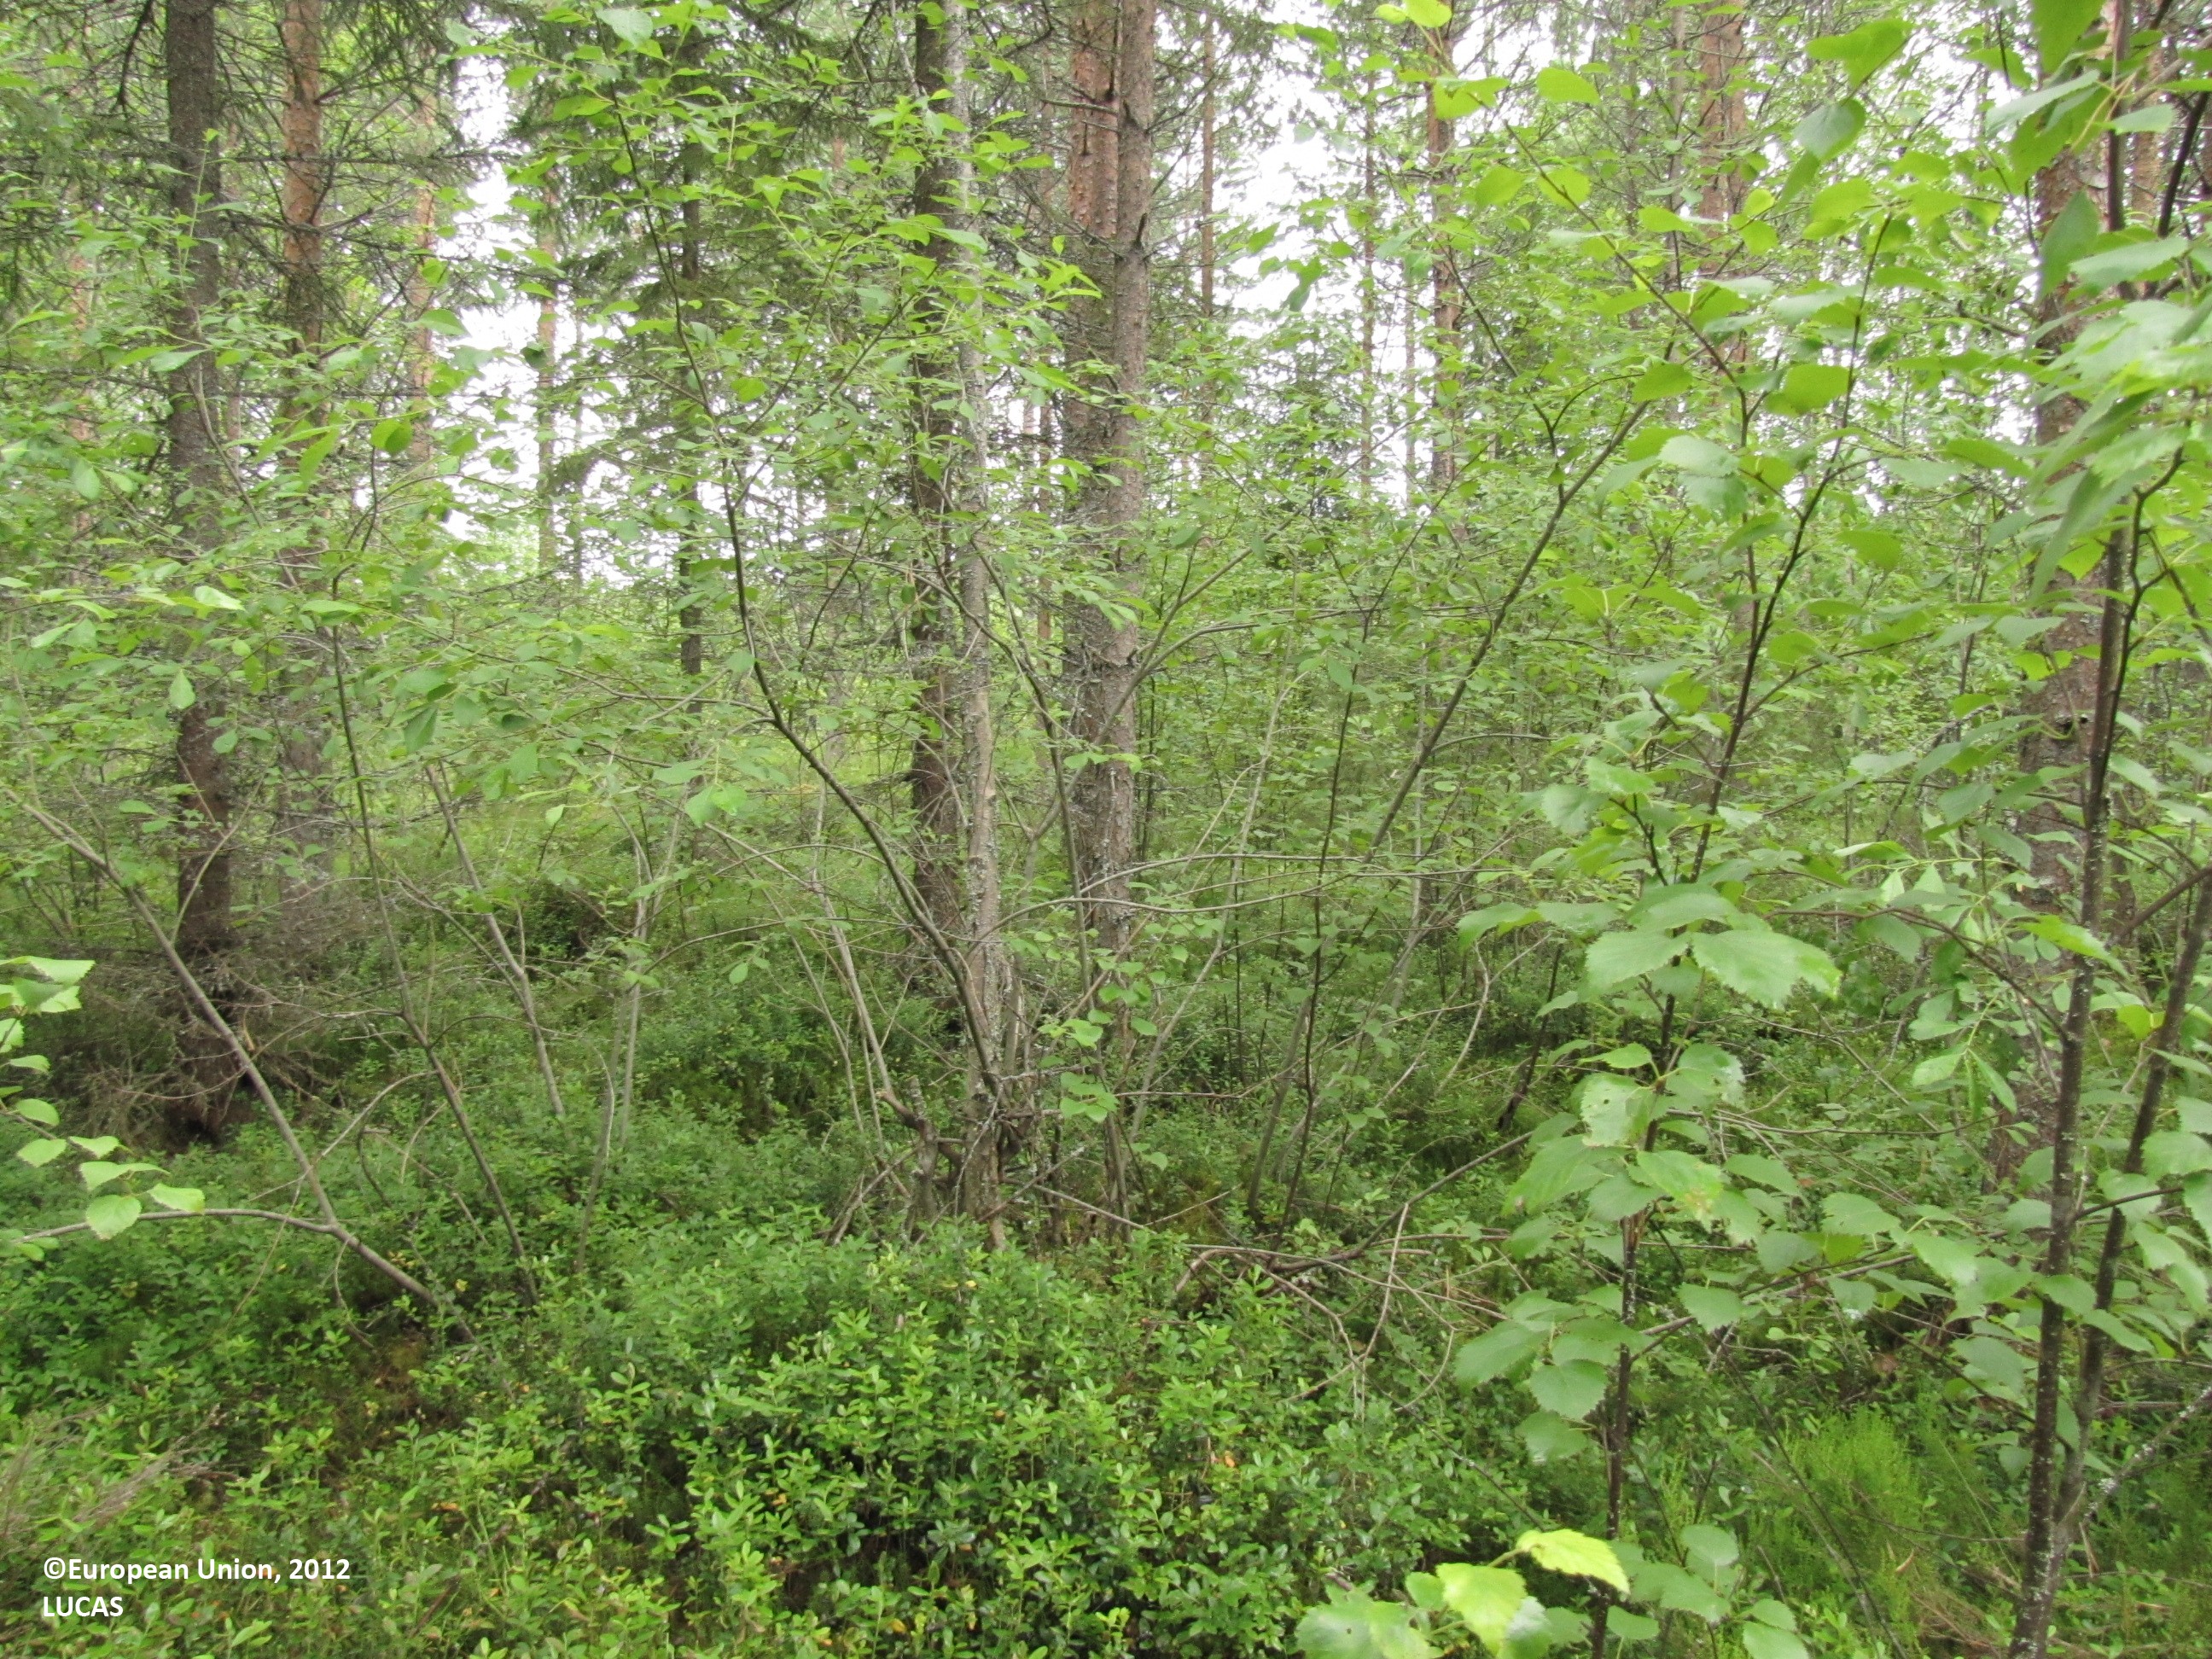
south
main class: Woodland
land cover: Pine dominated mixed woodland
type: boreal forest
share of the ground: > 75 %
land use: Forestry
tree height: > 5 m
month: July
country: FI
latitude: 62.5048
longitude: 24.0010
